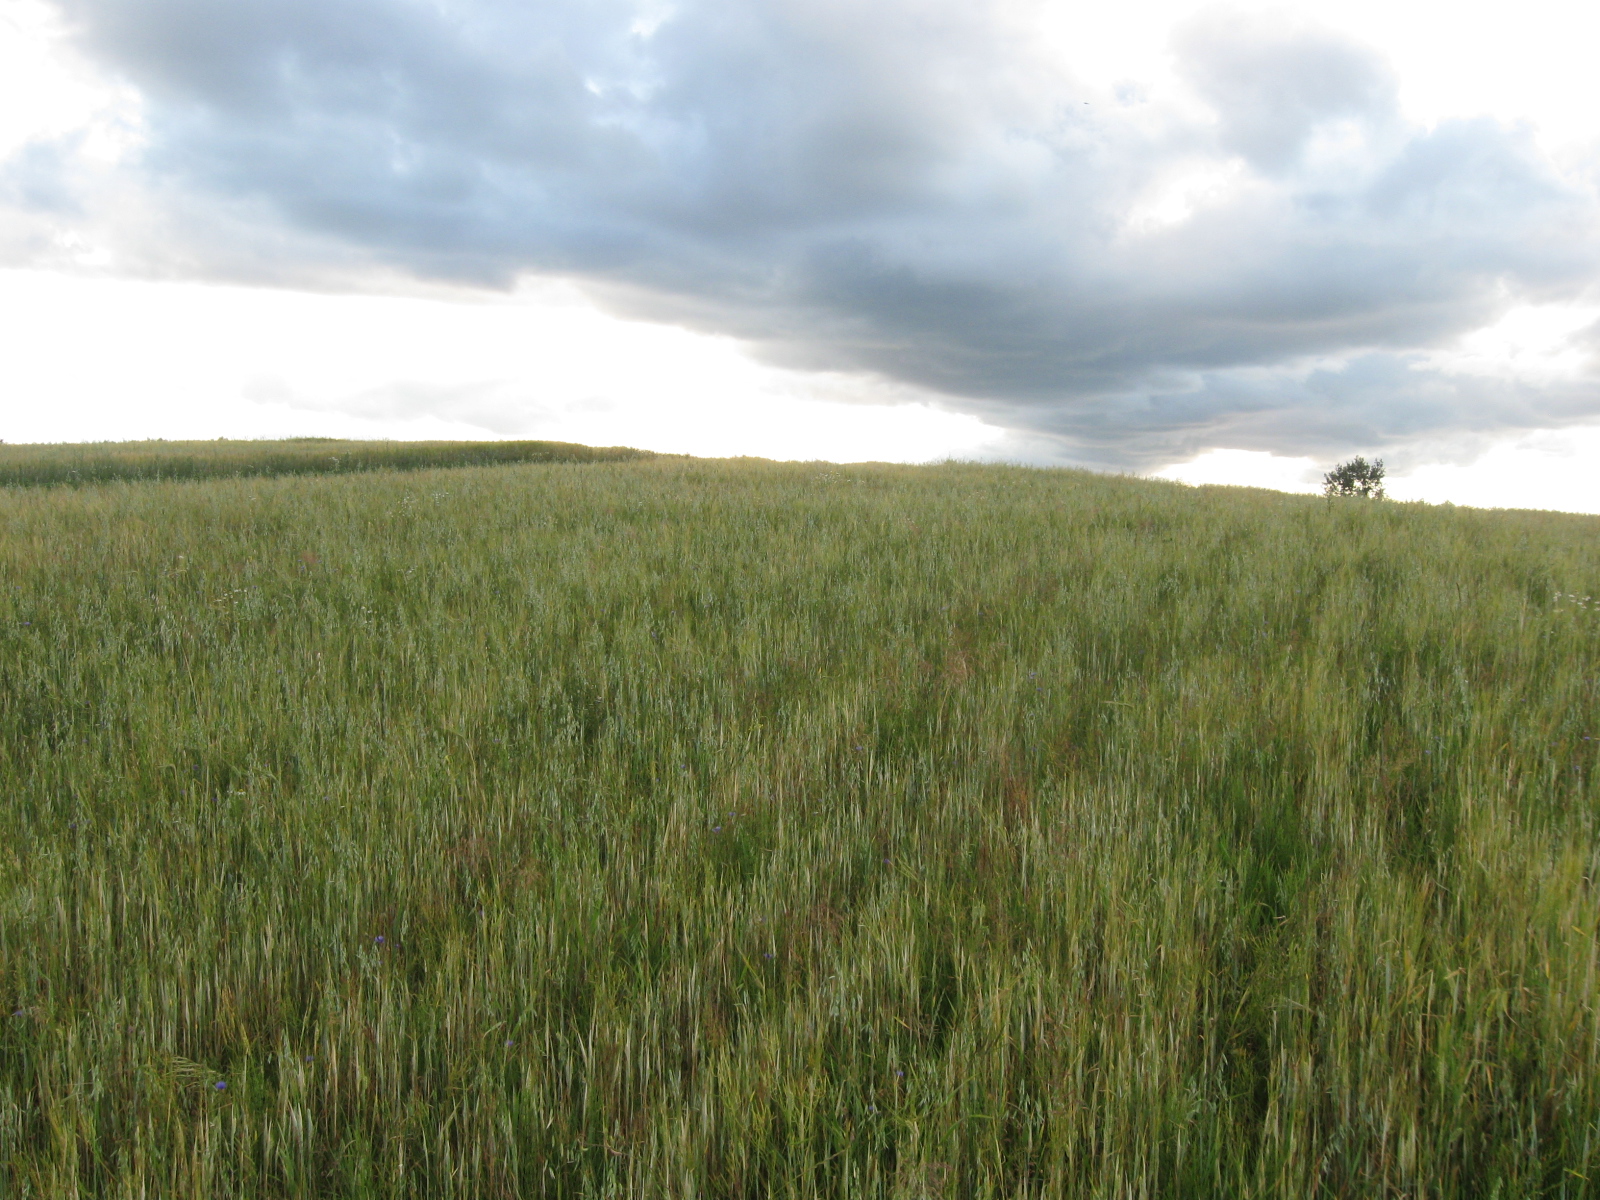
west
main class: Cropland
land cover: Barley
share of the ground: > 75 %
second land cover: Oats
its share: 10 - 25 %
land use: Agriculture (excluding fallow land and kitchen gardens)
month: July
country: LT
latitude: 54.3496
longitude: 24.3621
